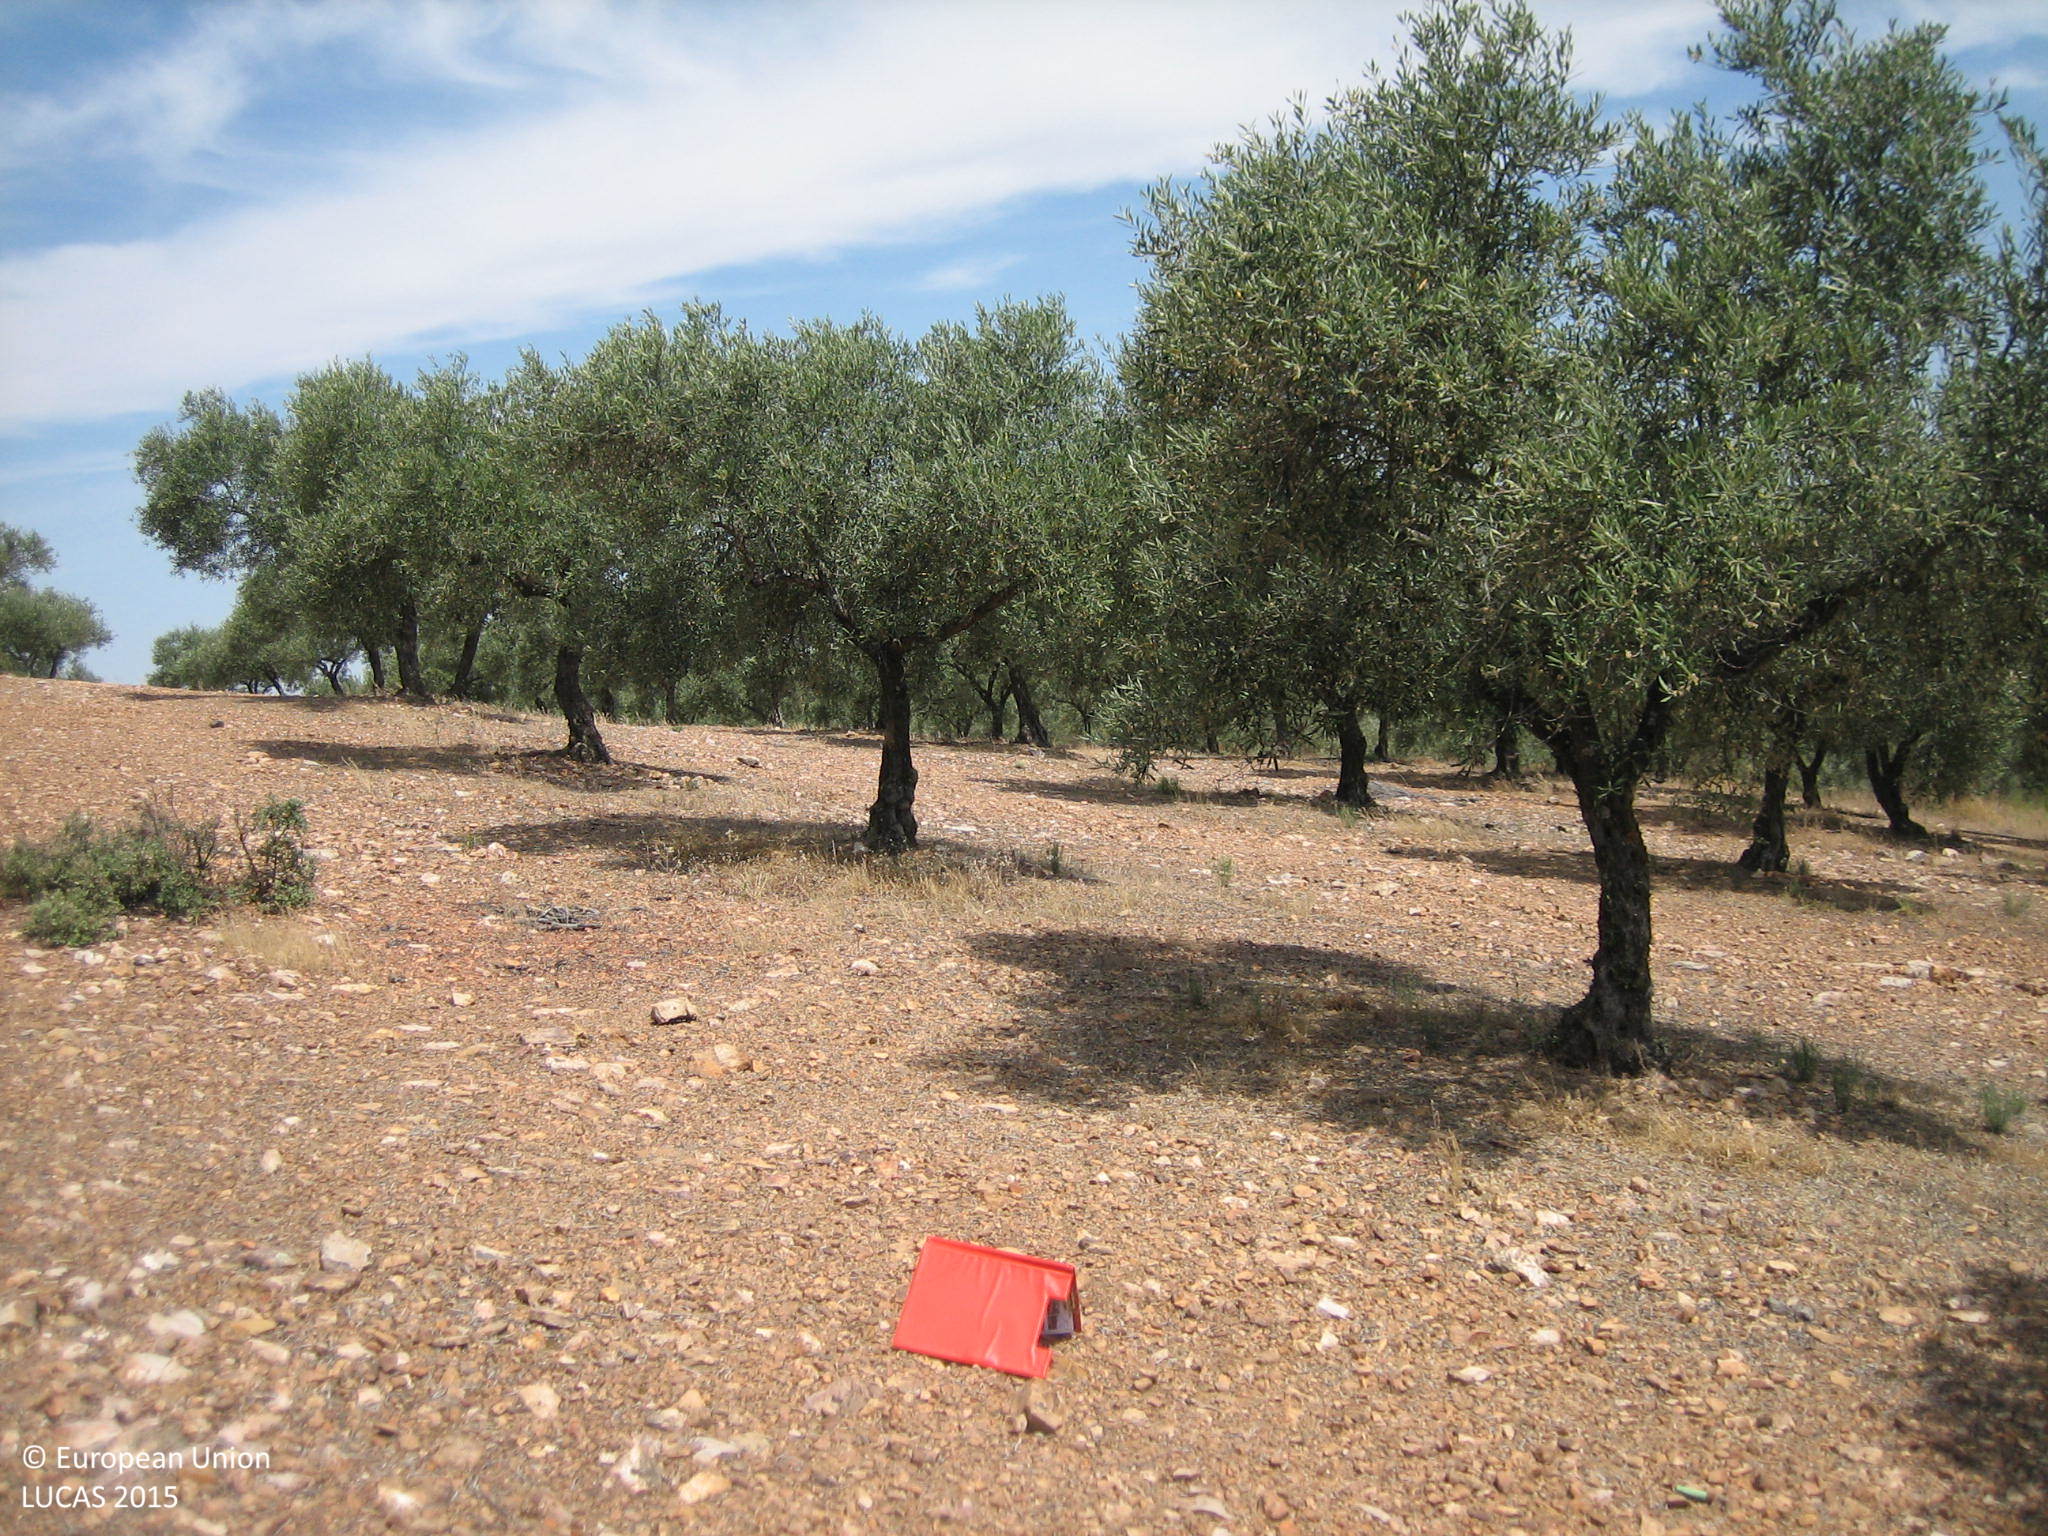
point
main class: Cropland
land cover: Olive groves
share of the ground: 25 - 50 %
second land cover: Other bare soil
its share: > 75 %
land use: Agriculture (excluding fallow land and kitchen gardens)
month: June
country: ES
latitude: 38.9734
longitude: -4.7948
